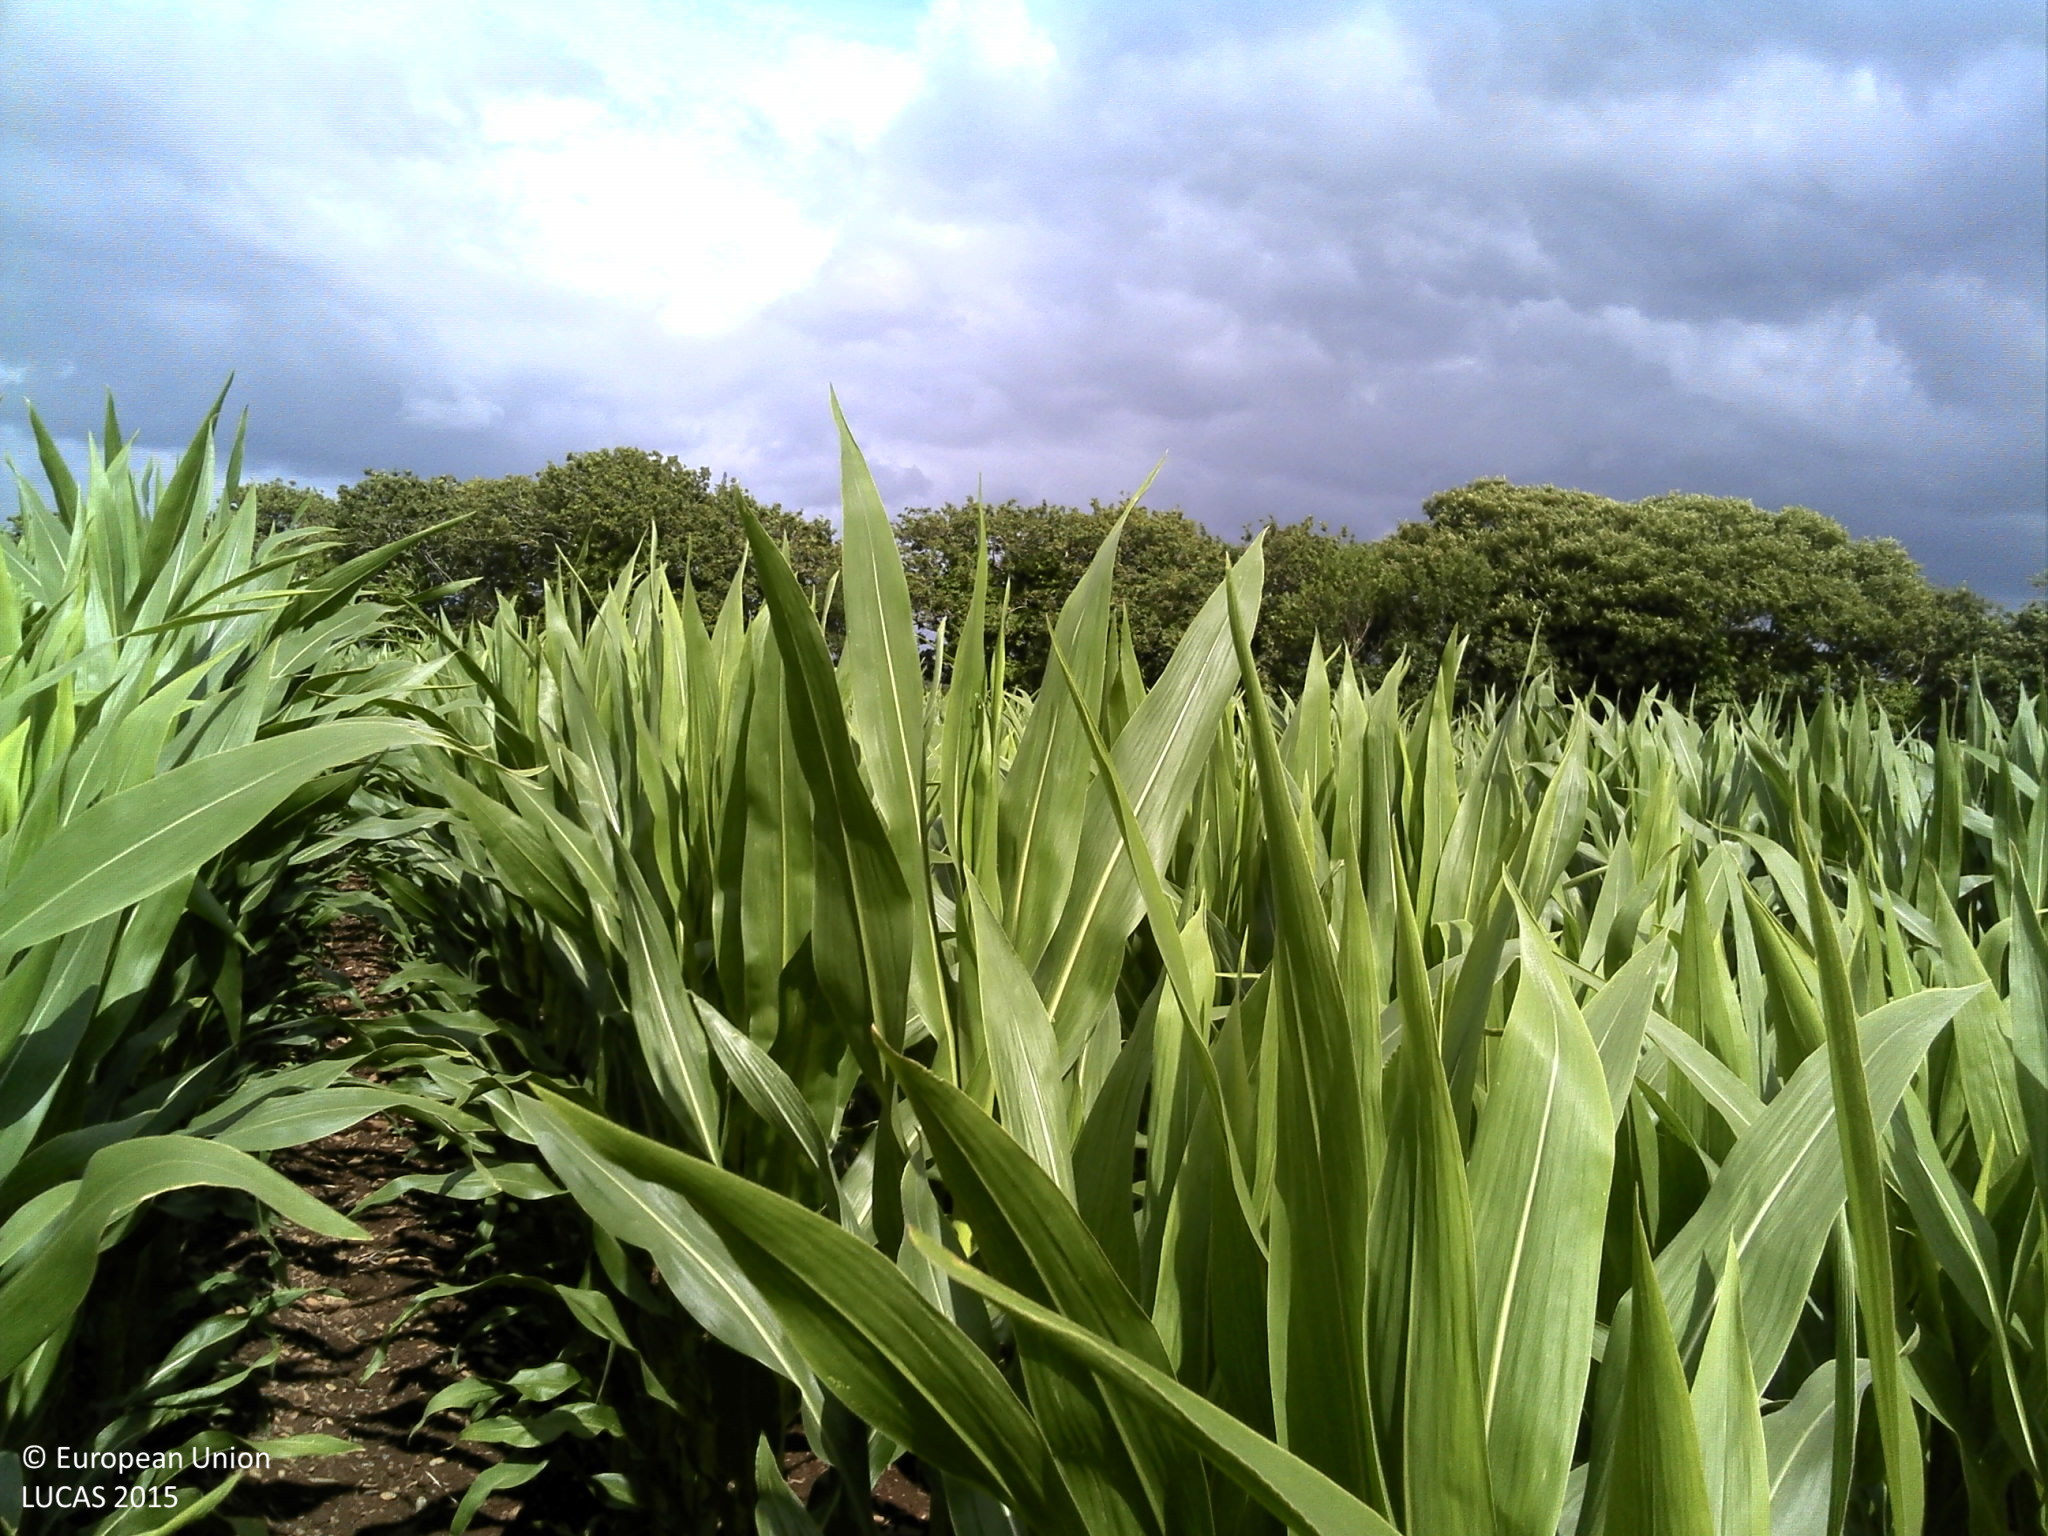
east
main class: Cropland
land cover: Maize
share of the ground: > 75 %
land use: Agriculture (excluding fallow land and kitchen gardens)
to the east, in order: Maize; Broadleaved woodland; Grassland without tree/shrub cover; Grassland with sparse tree/shrub cover; Managed hedges; Ditches and canals; Grass margins; Paved roads, cycling and walking lanes; Grass margins; Broadleaved woodland; Dry stone walls; Broadleaved woodland; Spontaneously vegetated surfaces; Electric lines; Spontaneously vegetated surfaces
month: July
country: FR
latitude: 48.2528
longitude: -4.1653
